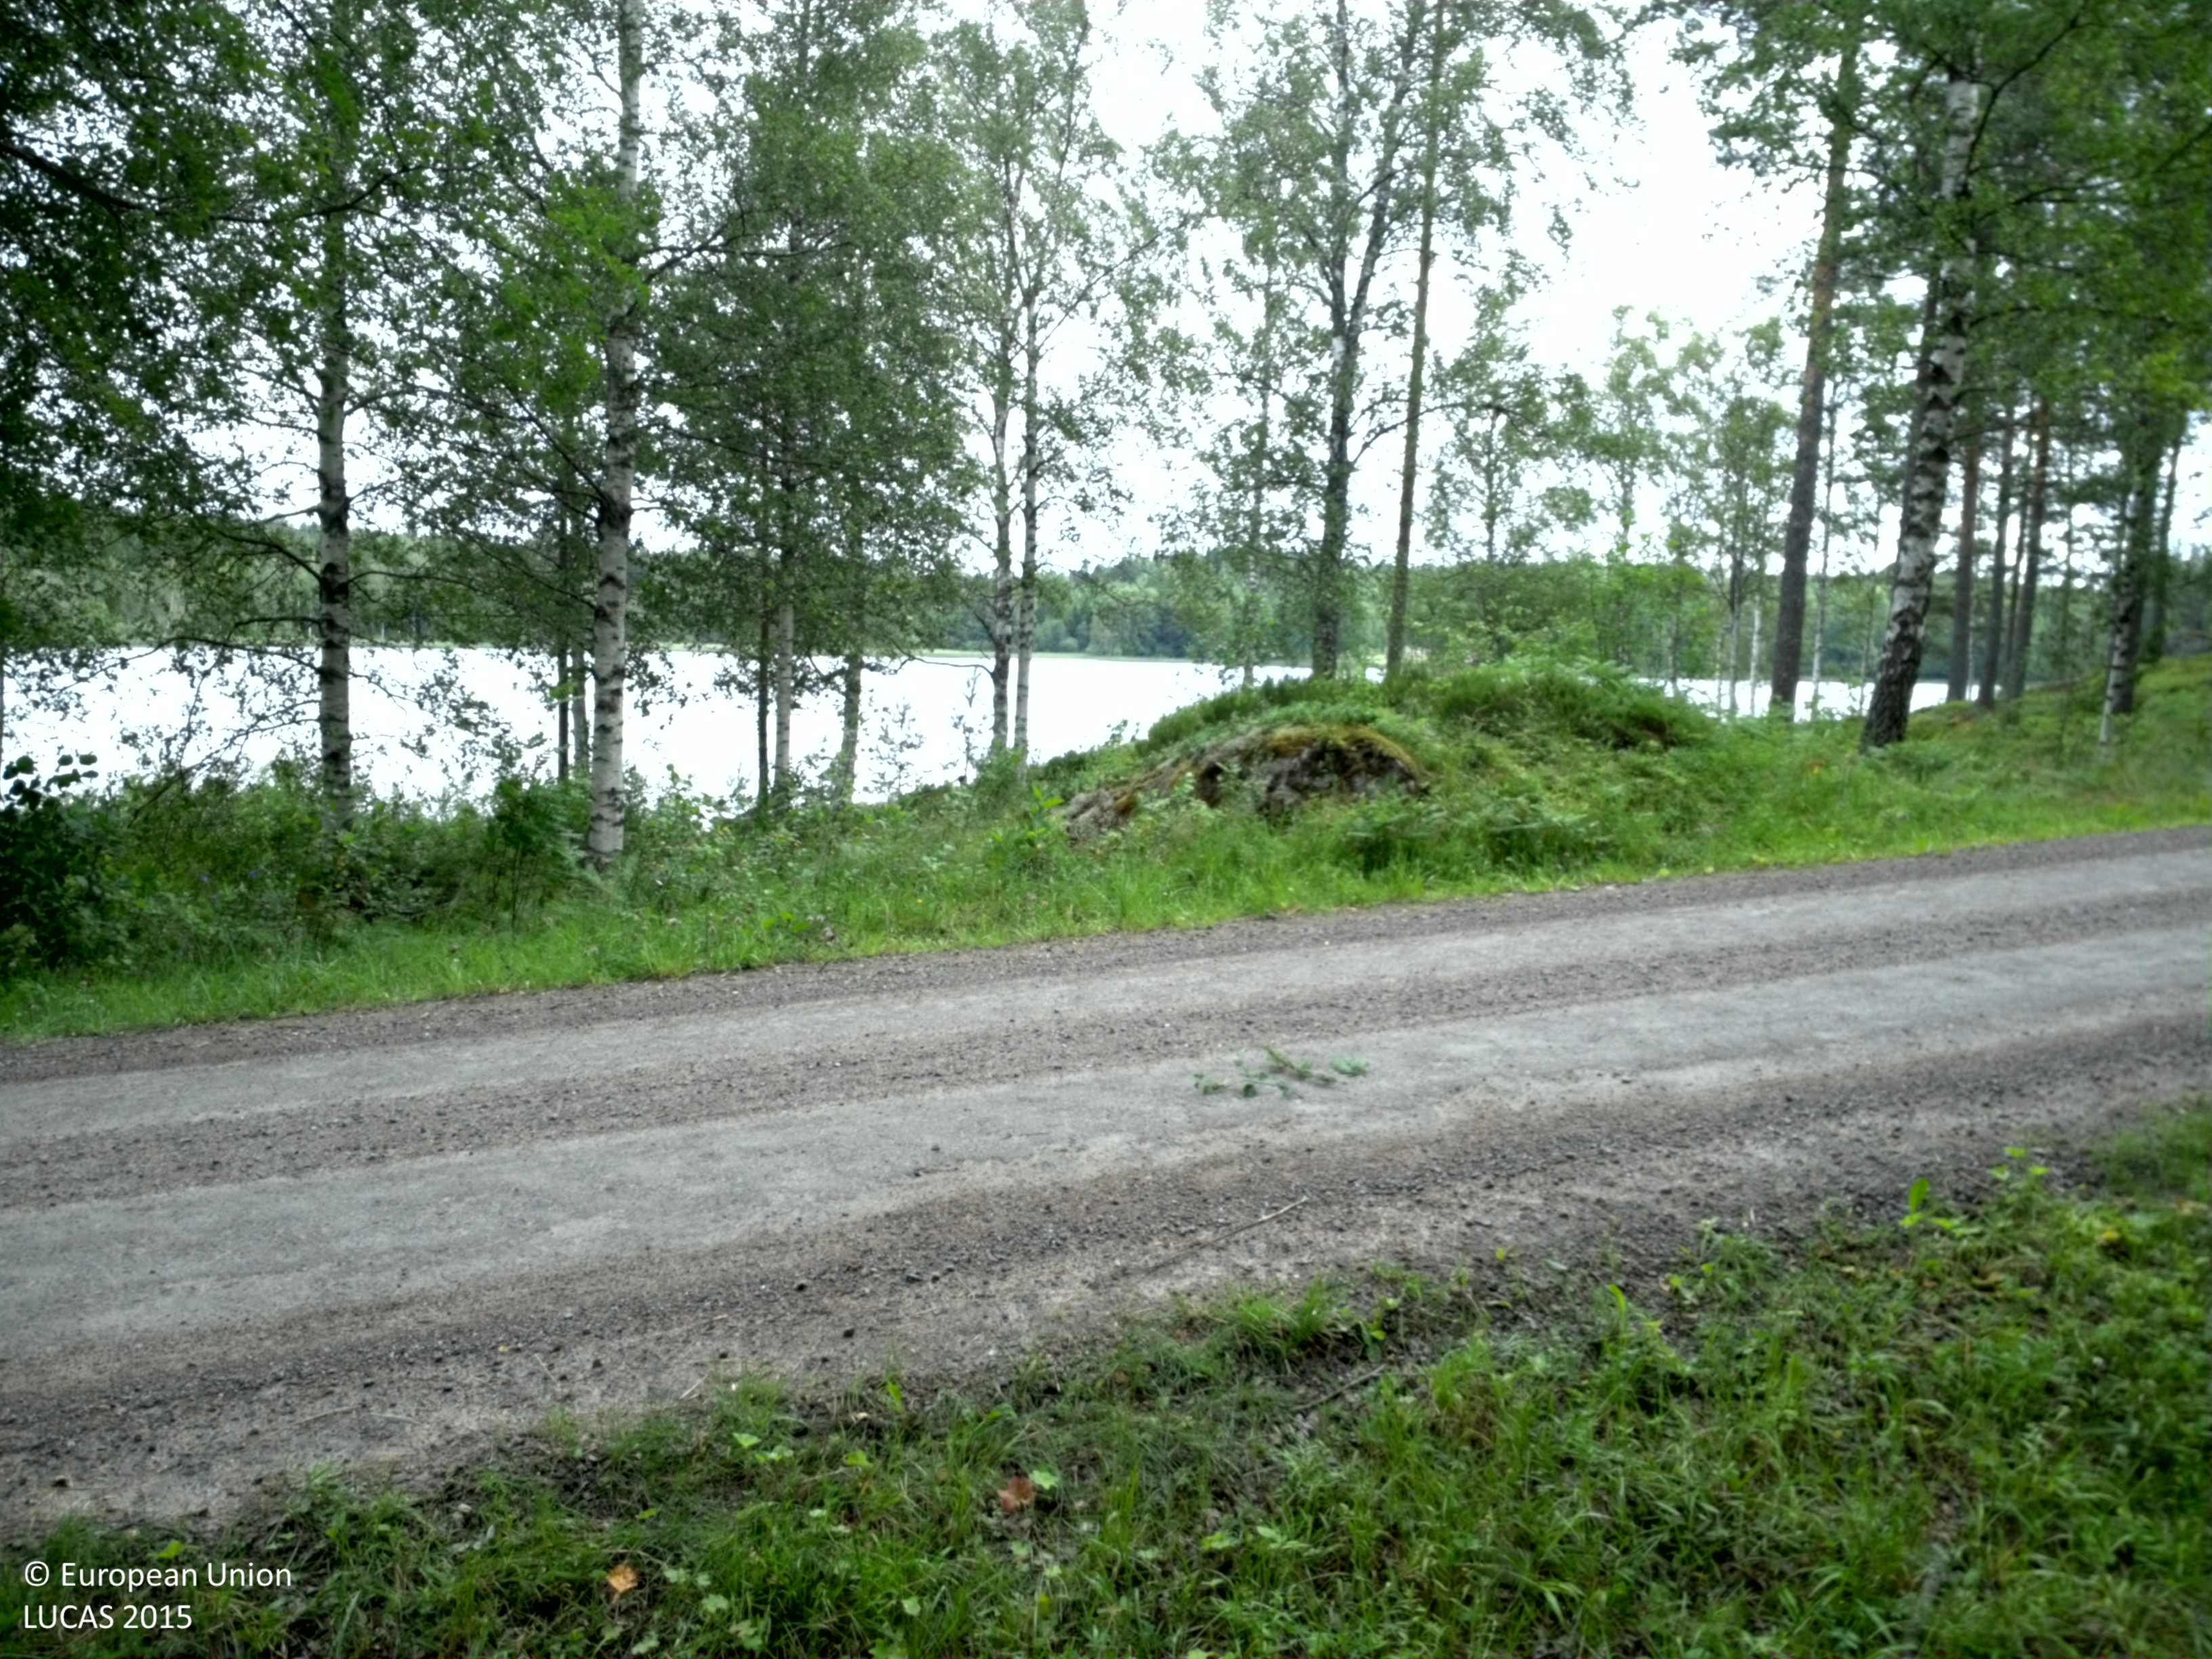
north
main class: Woodland
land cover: Spruce dominated mixed woodland
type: boreal forest
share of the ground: 25 - 50 %
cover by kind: coniferous forest trees 30 %, herbaceous plants 30 %, broadleaved forest trees 15 %, lichens and mosses 15 %, shrubs 10 %
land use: Forestry
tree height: > 5 m
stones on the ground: 10 - 25 %
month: July
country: SE
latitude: 58.9089
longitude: 14.8017
